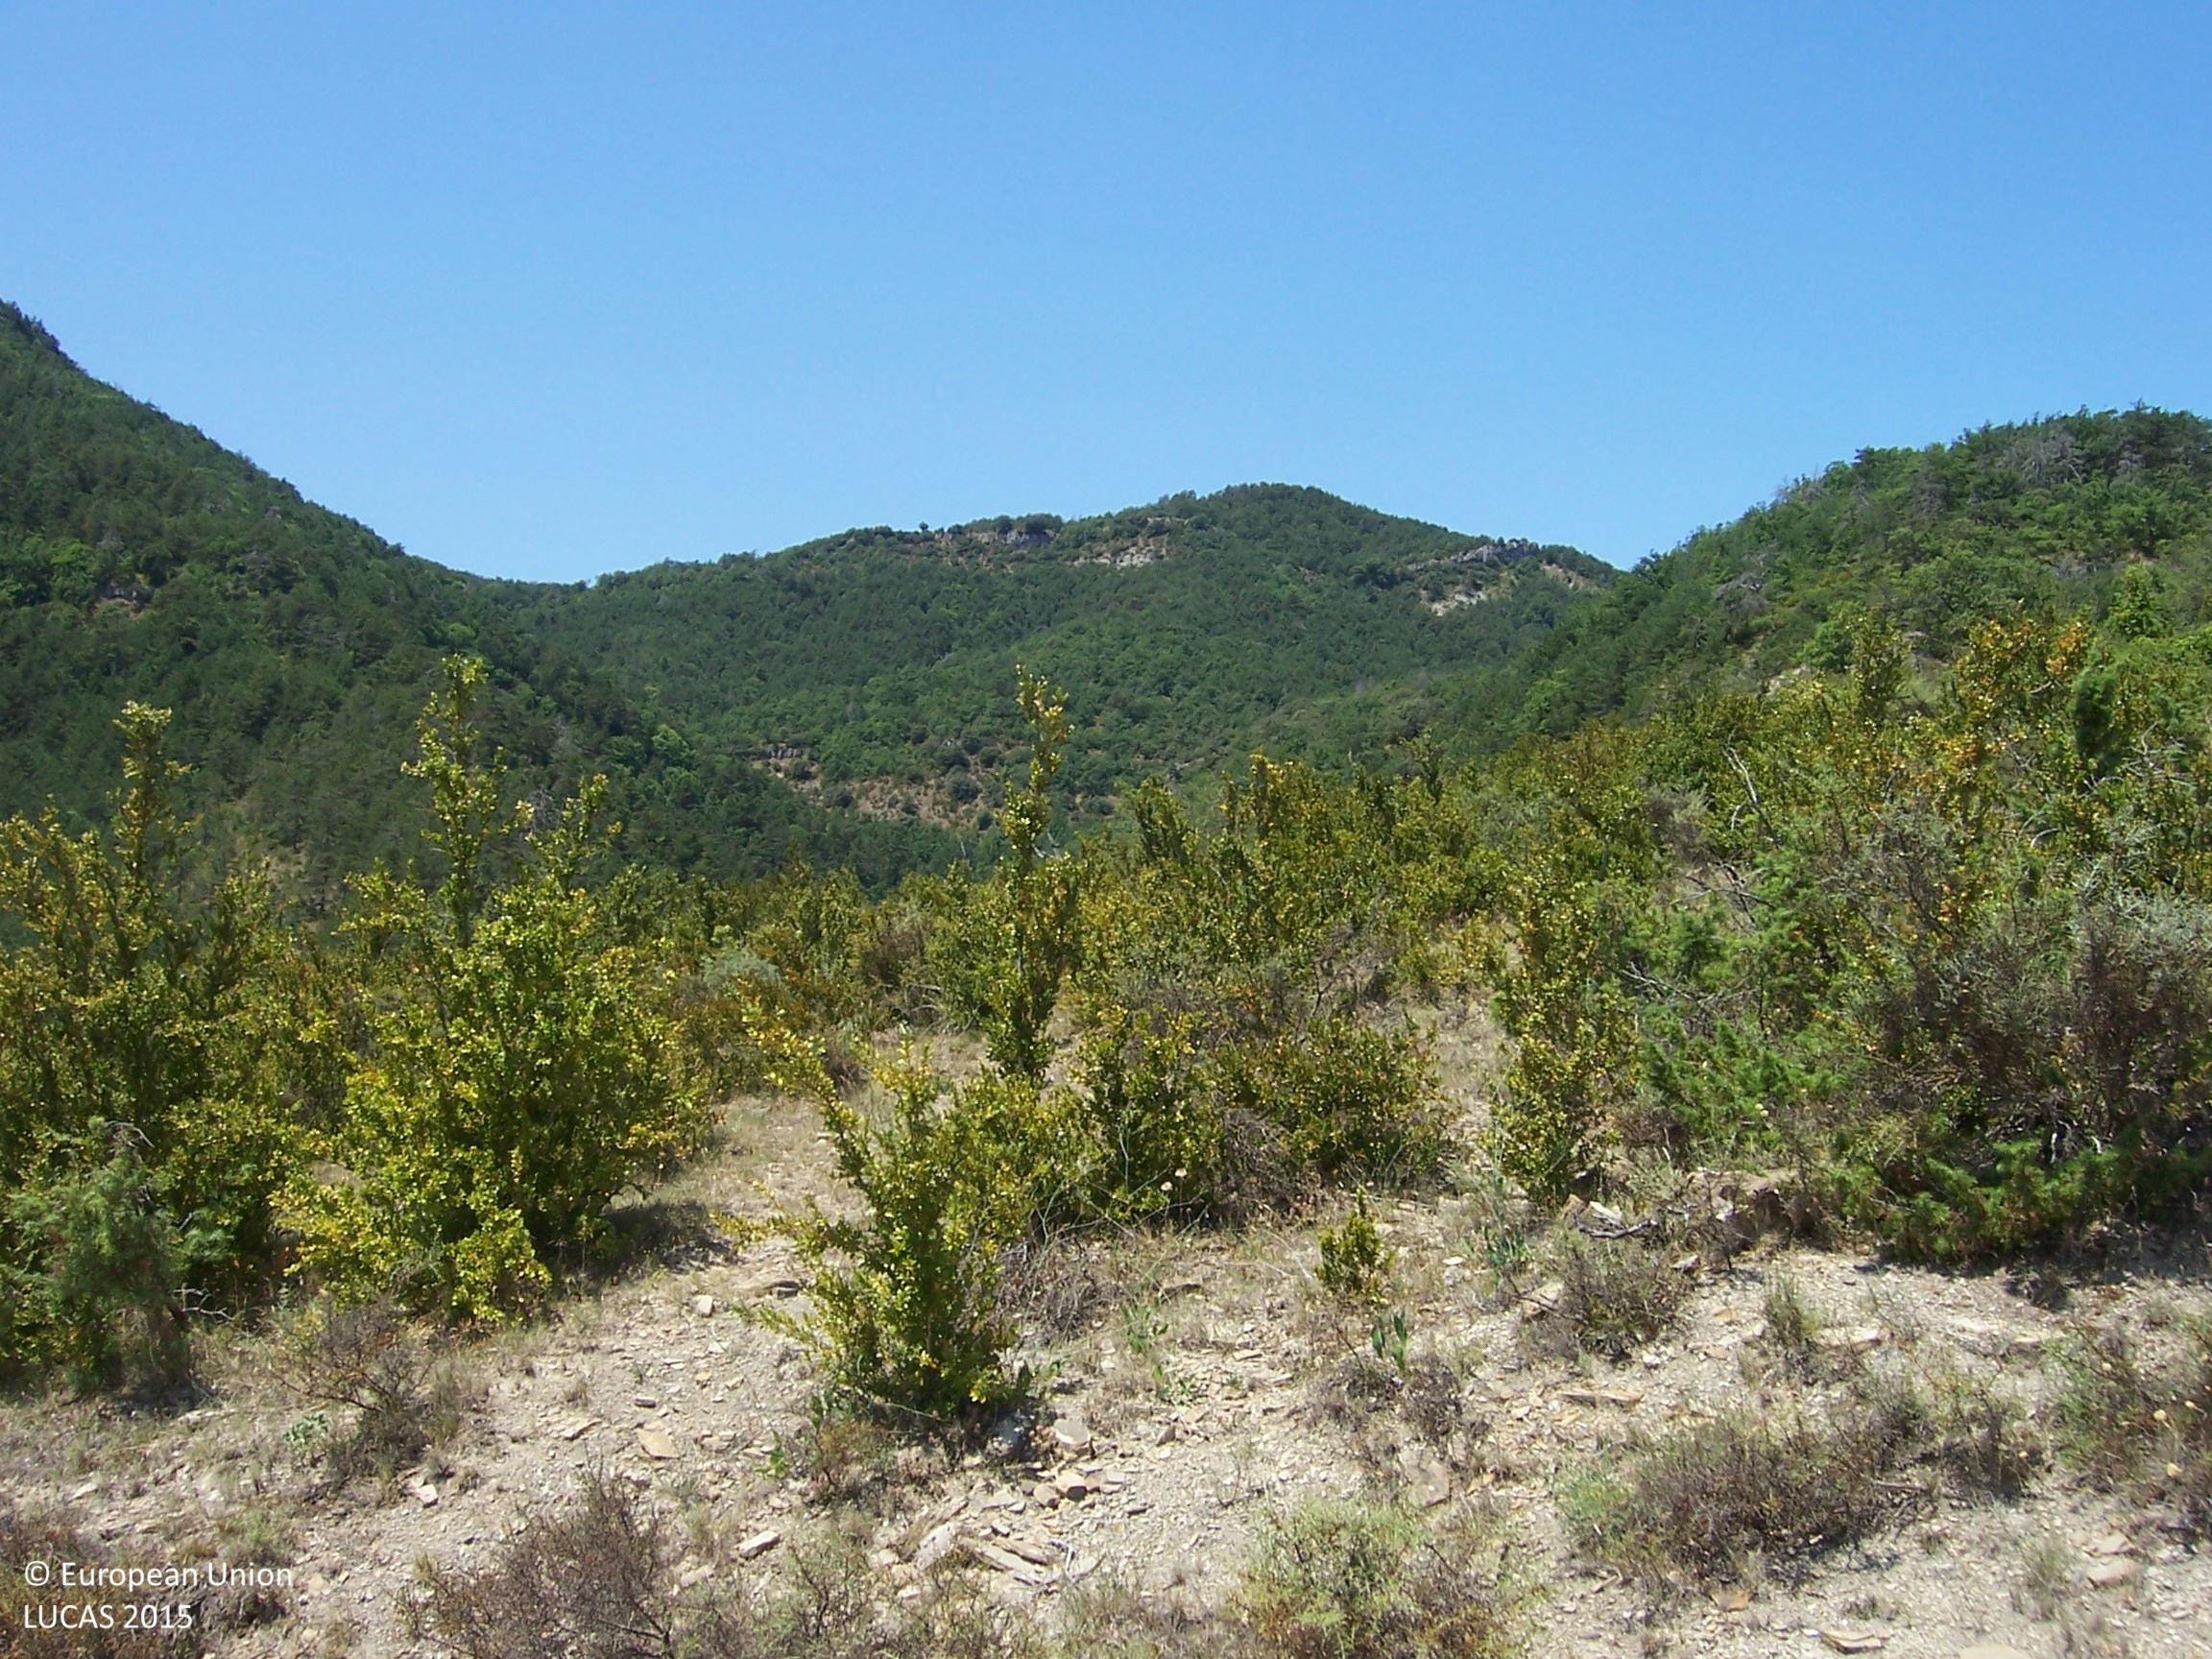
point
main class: Woodland
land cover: Pine dominated coniferous woodland
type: coniferous forest of the mediterranean region
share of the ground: > 75 %
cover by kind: coniferous forest trees 100 %
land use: Forestry
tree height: > 5 m
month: July
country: ES
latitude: 42.8263
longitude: -1.2524
